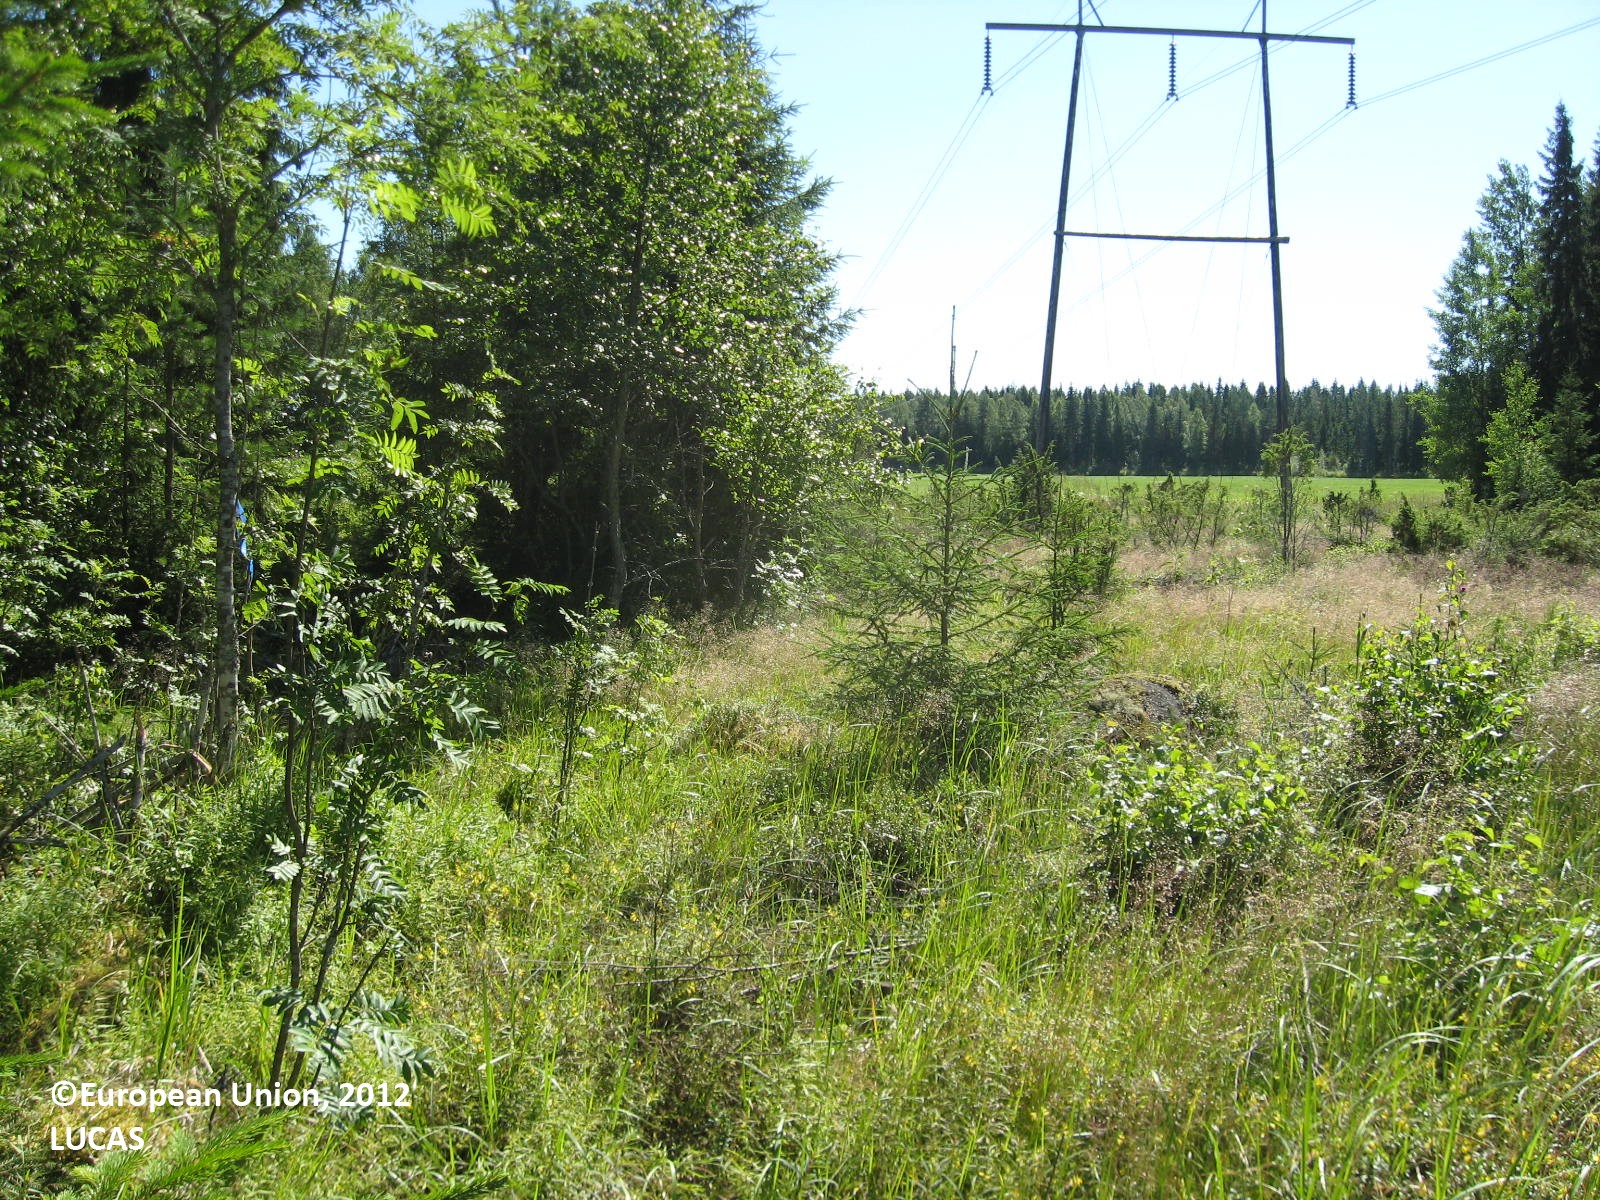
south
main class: Woodland
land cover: Spruce dominated mixed woodland
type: boreal forest
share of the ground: 50 - 75 %
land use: Energy production
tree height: > 5 m
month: July
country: FI
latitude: 62.1578
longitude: 21.6595
